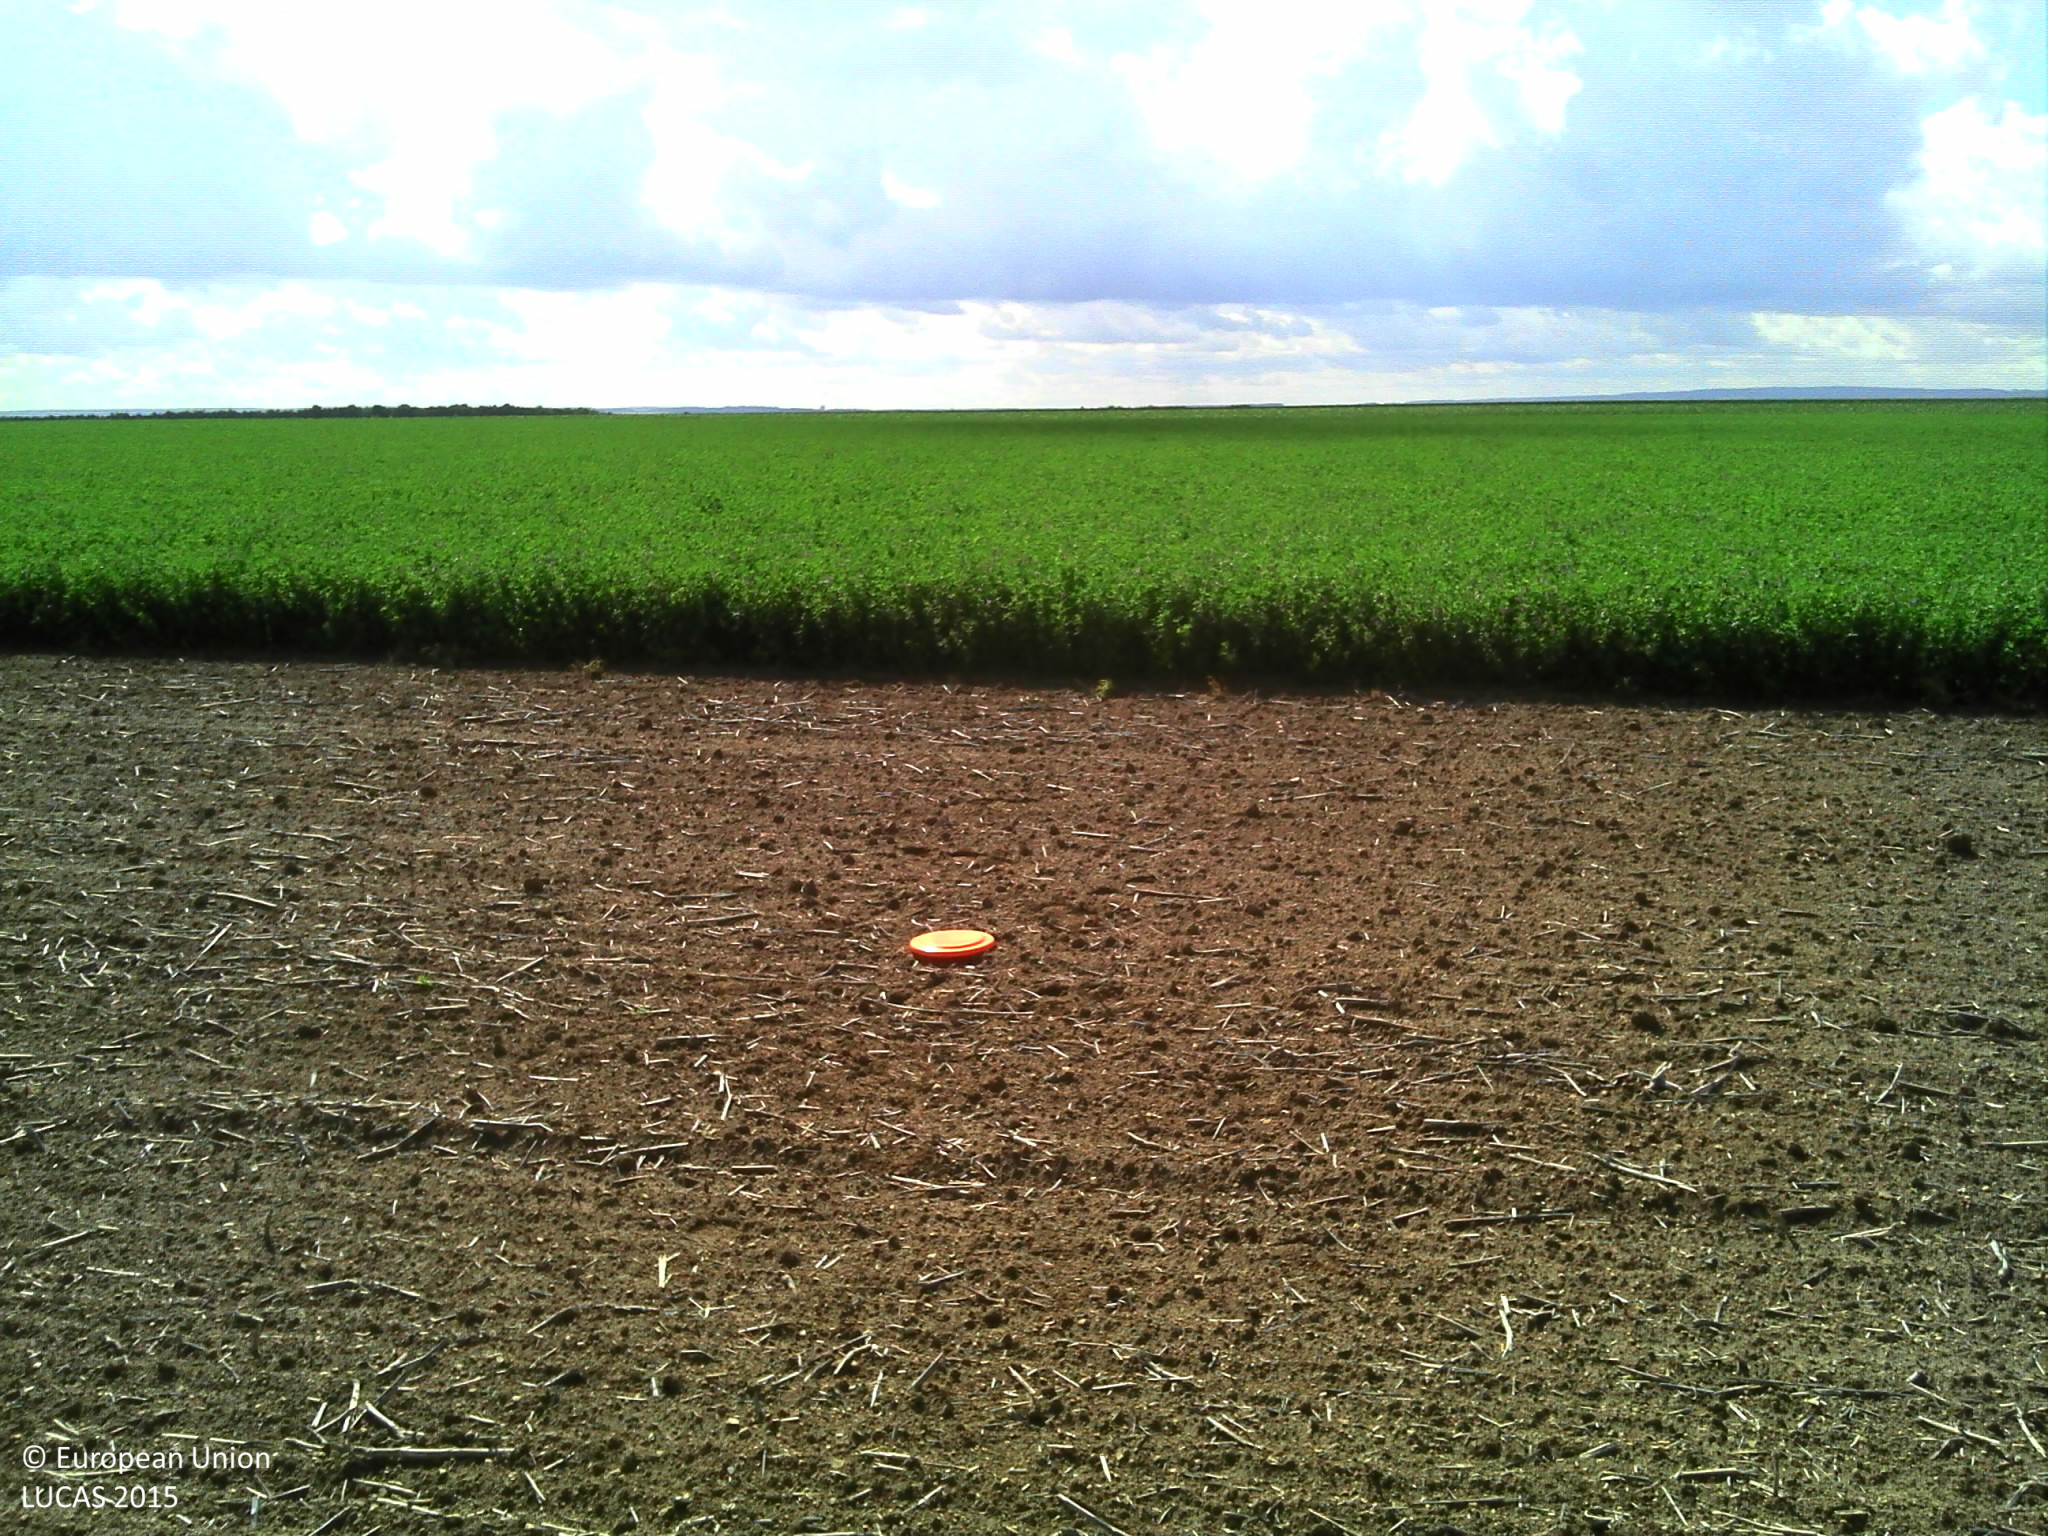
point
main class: Cropland
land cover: Rape and turnip rape
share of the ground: 25 - 50 %
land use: Agriculture (excluding fallow land and kitchen gardens)
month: September
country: FR
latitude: 48.3753
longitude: 3.8256
